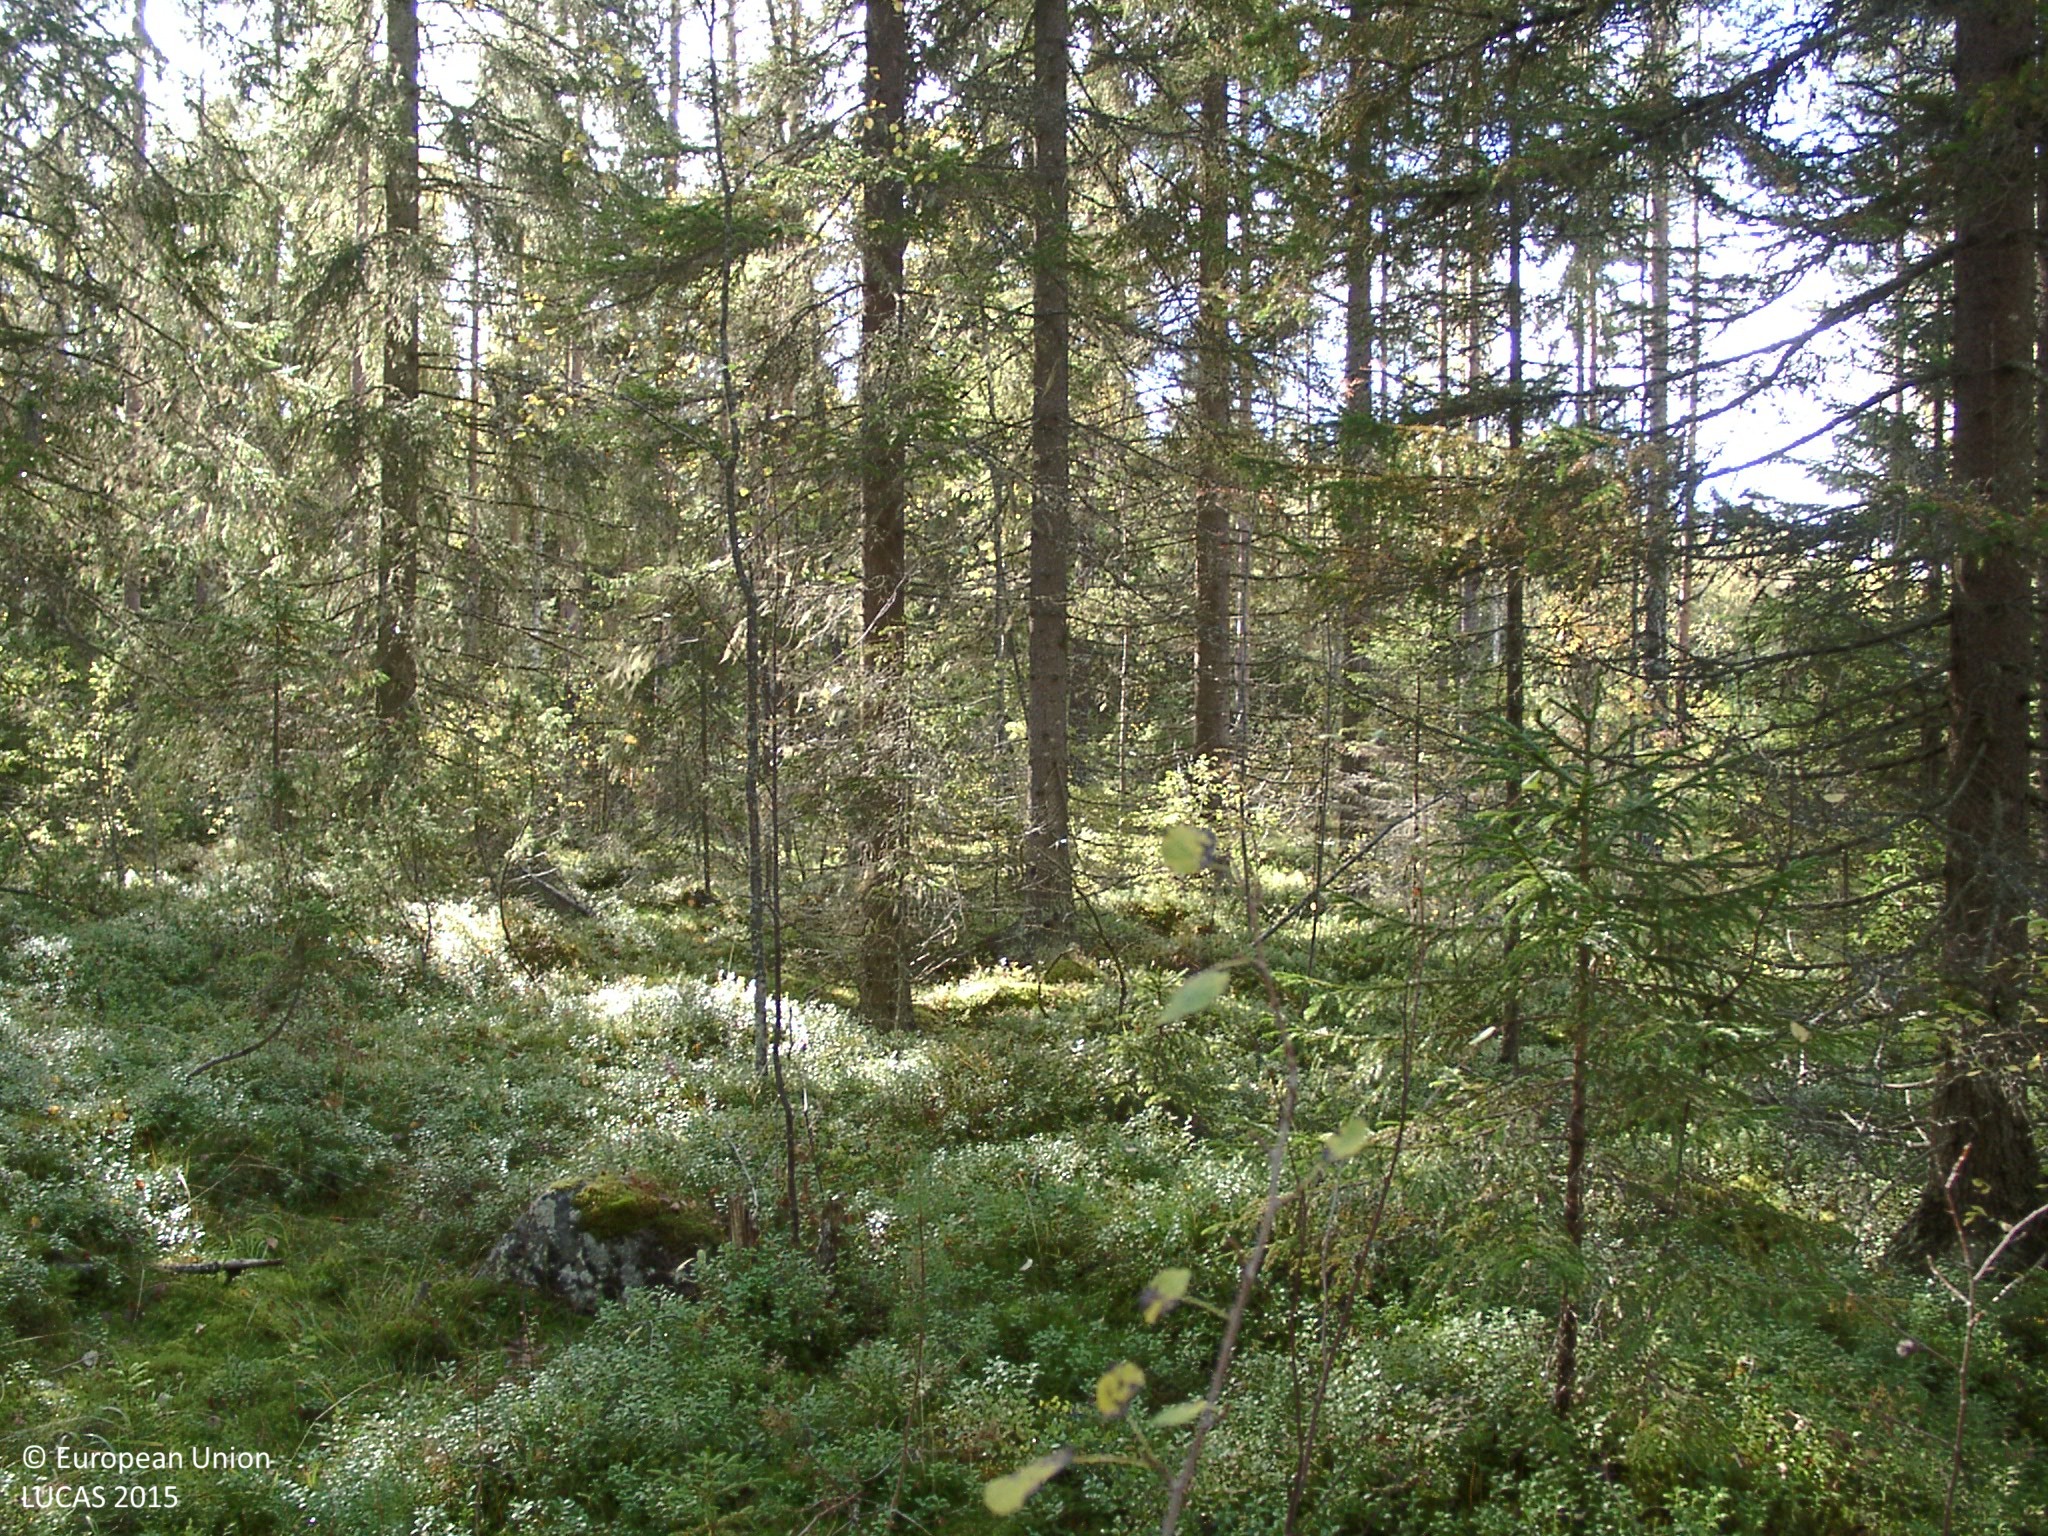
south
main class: Woodland
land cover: Pine dominated coniferous woodland
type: boreal forest
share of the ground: 50 - 75 %
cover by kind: coniferous forest trees 55 %, shrubs 25 %, broadleaved forest trees 10 %, herbaceous plants 5 %, lichens and mosses 5 %
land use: Forestry
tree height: > 5 m
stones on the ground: < 10 %
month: September
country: FI
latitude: 62.5260
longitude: 25.2808
